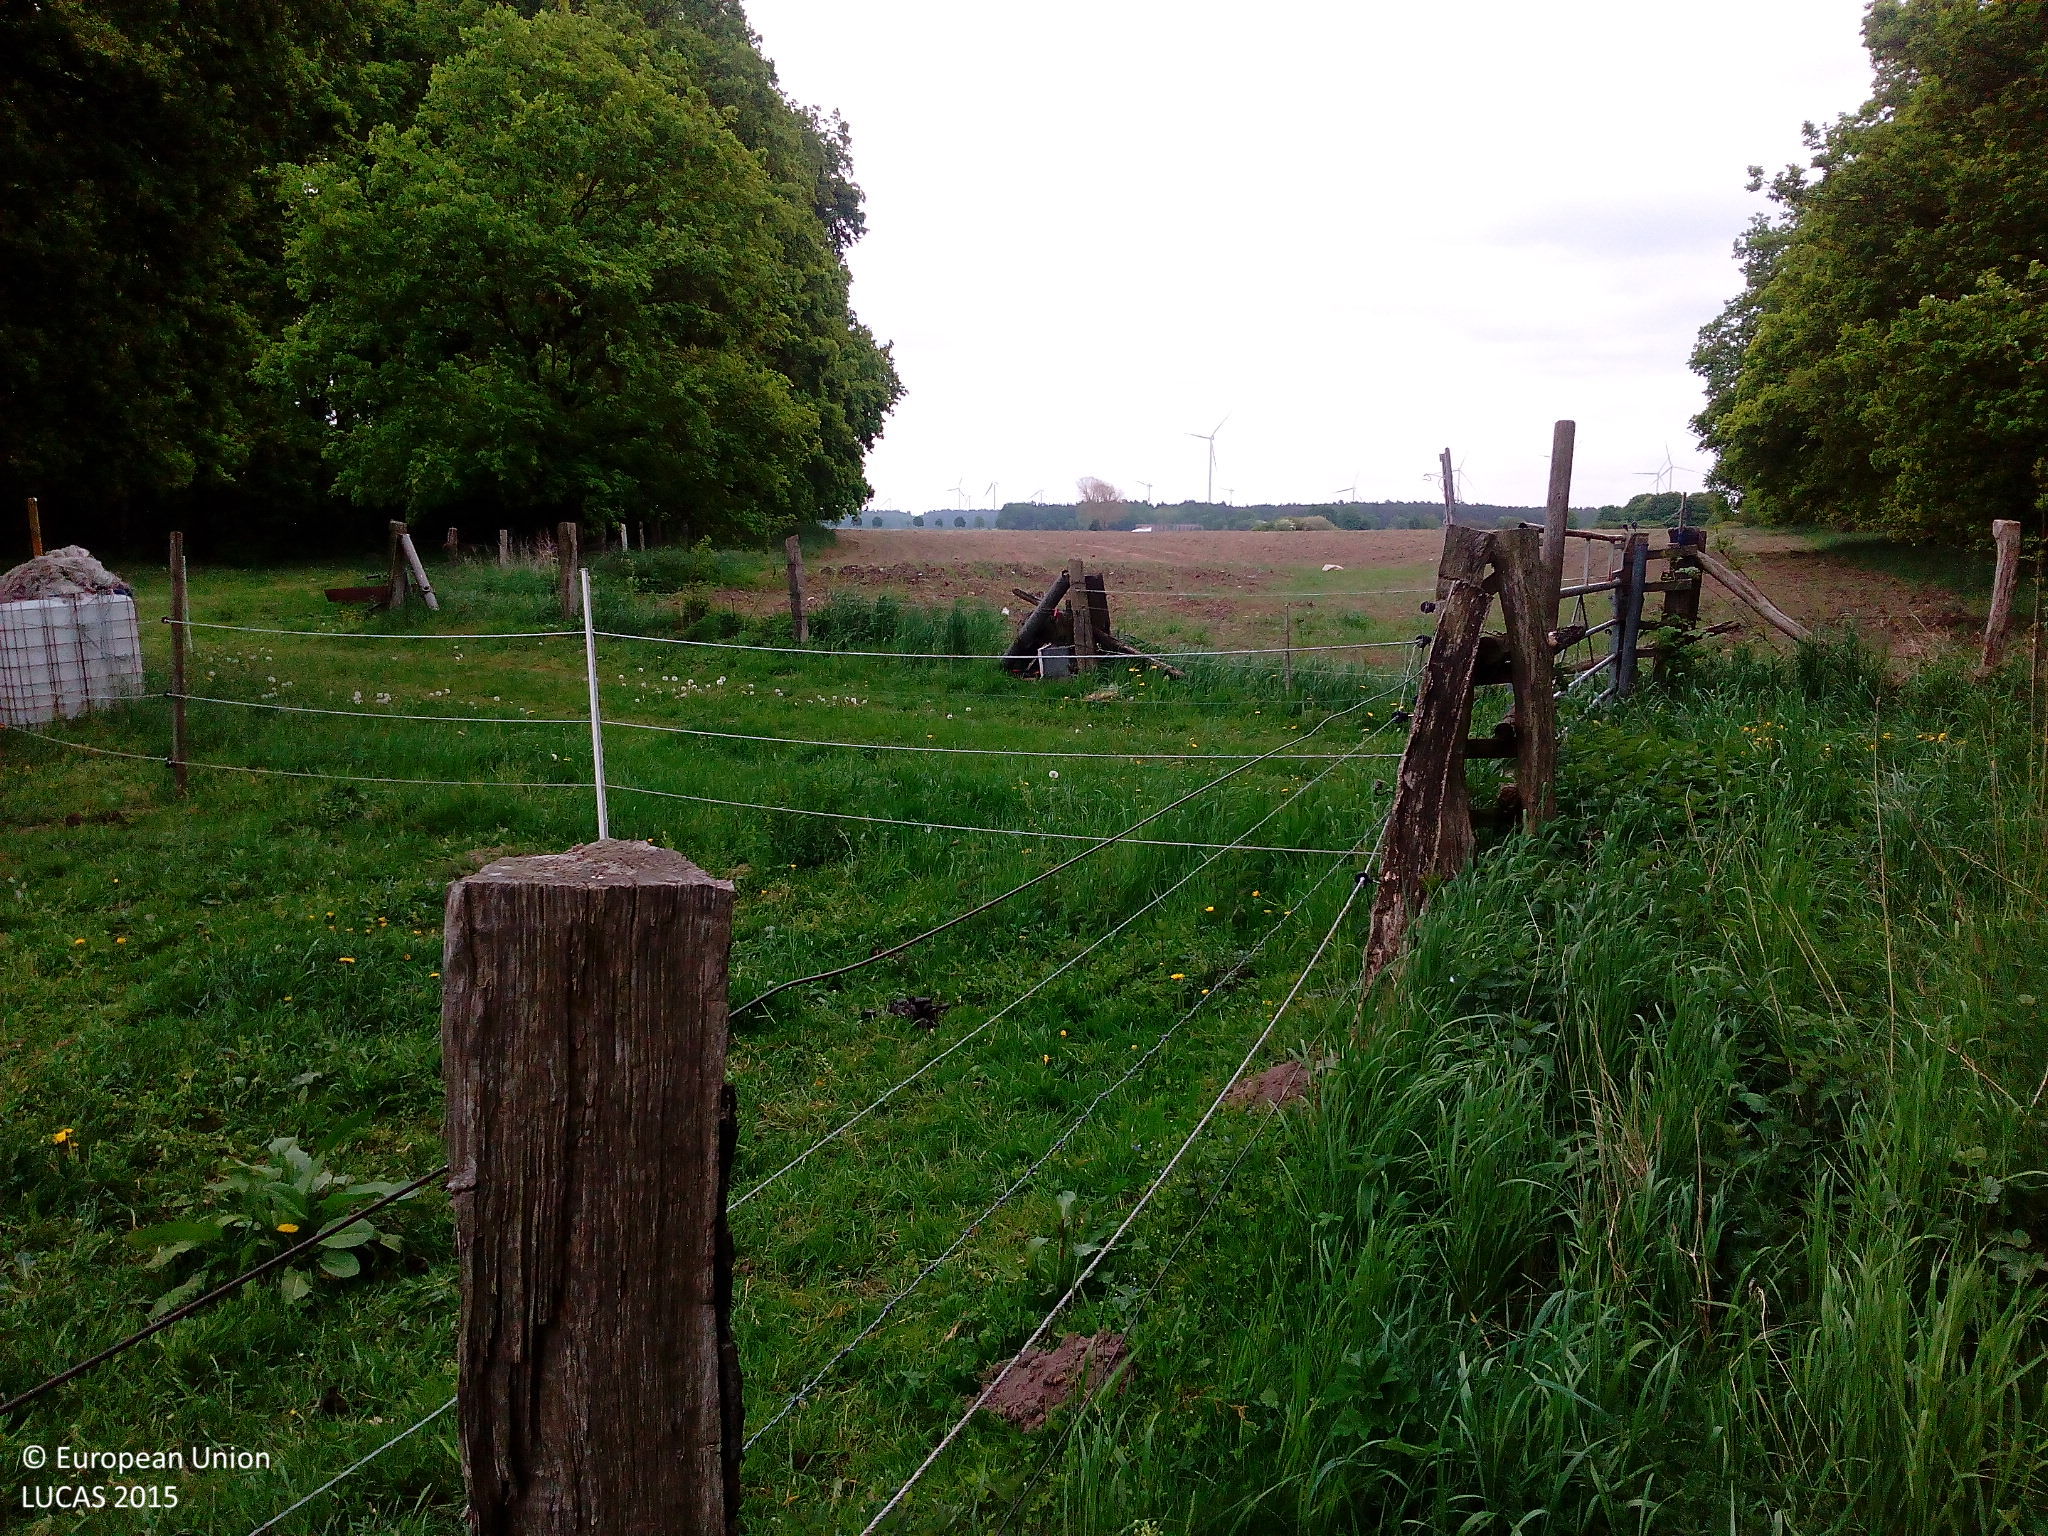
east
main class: Woodland
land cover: Broadleaved woodland
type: mesophytic deciduous forest
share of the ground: 10 - 25 %
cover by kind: herbaceous plants 80 %, broadleaved forest trees 20 %
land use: Agriculture (excluding fallow land and kitchen gardens)
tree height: > 5 m
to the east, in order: Broadleaved woodland; Fences; Maize; Fences; Shrubland without tree cover; Grassland without tree/shrub cover; Ditches and canals
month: May
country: DE
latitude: 52.8159
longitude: 11.6168
